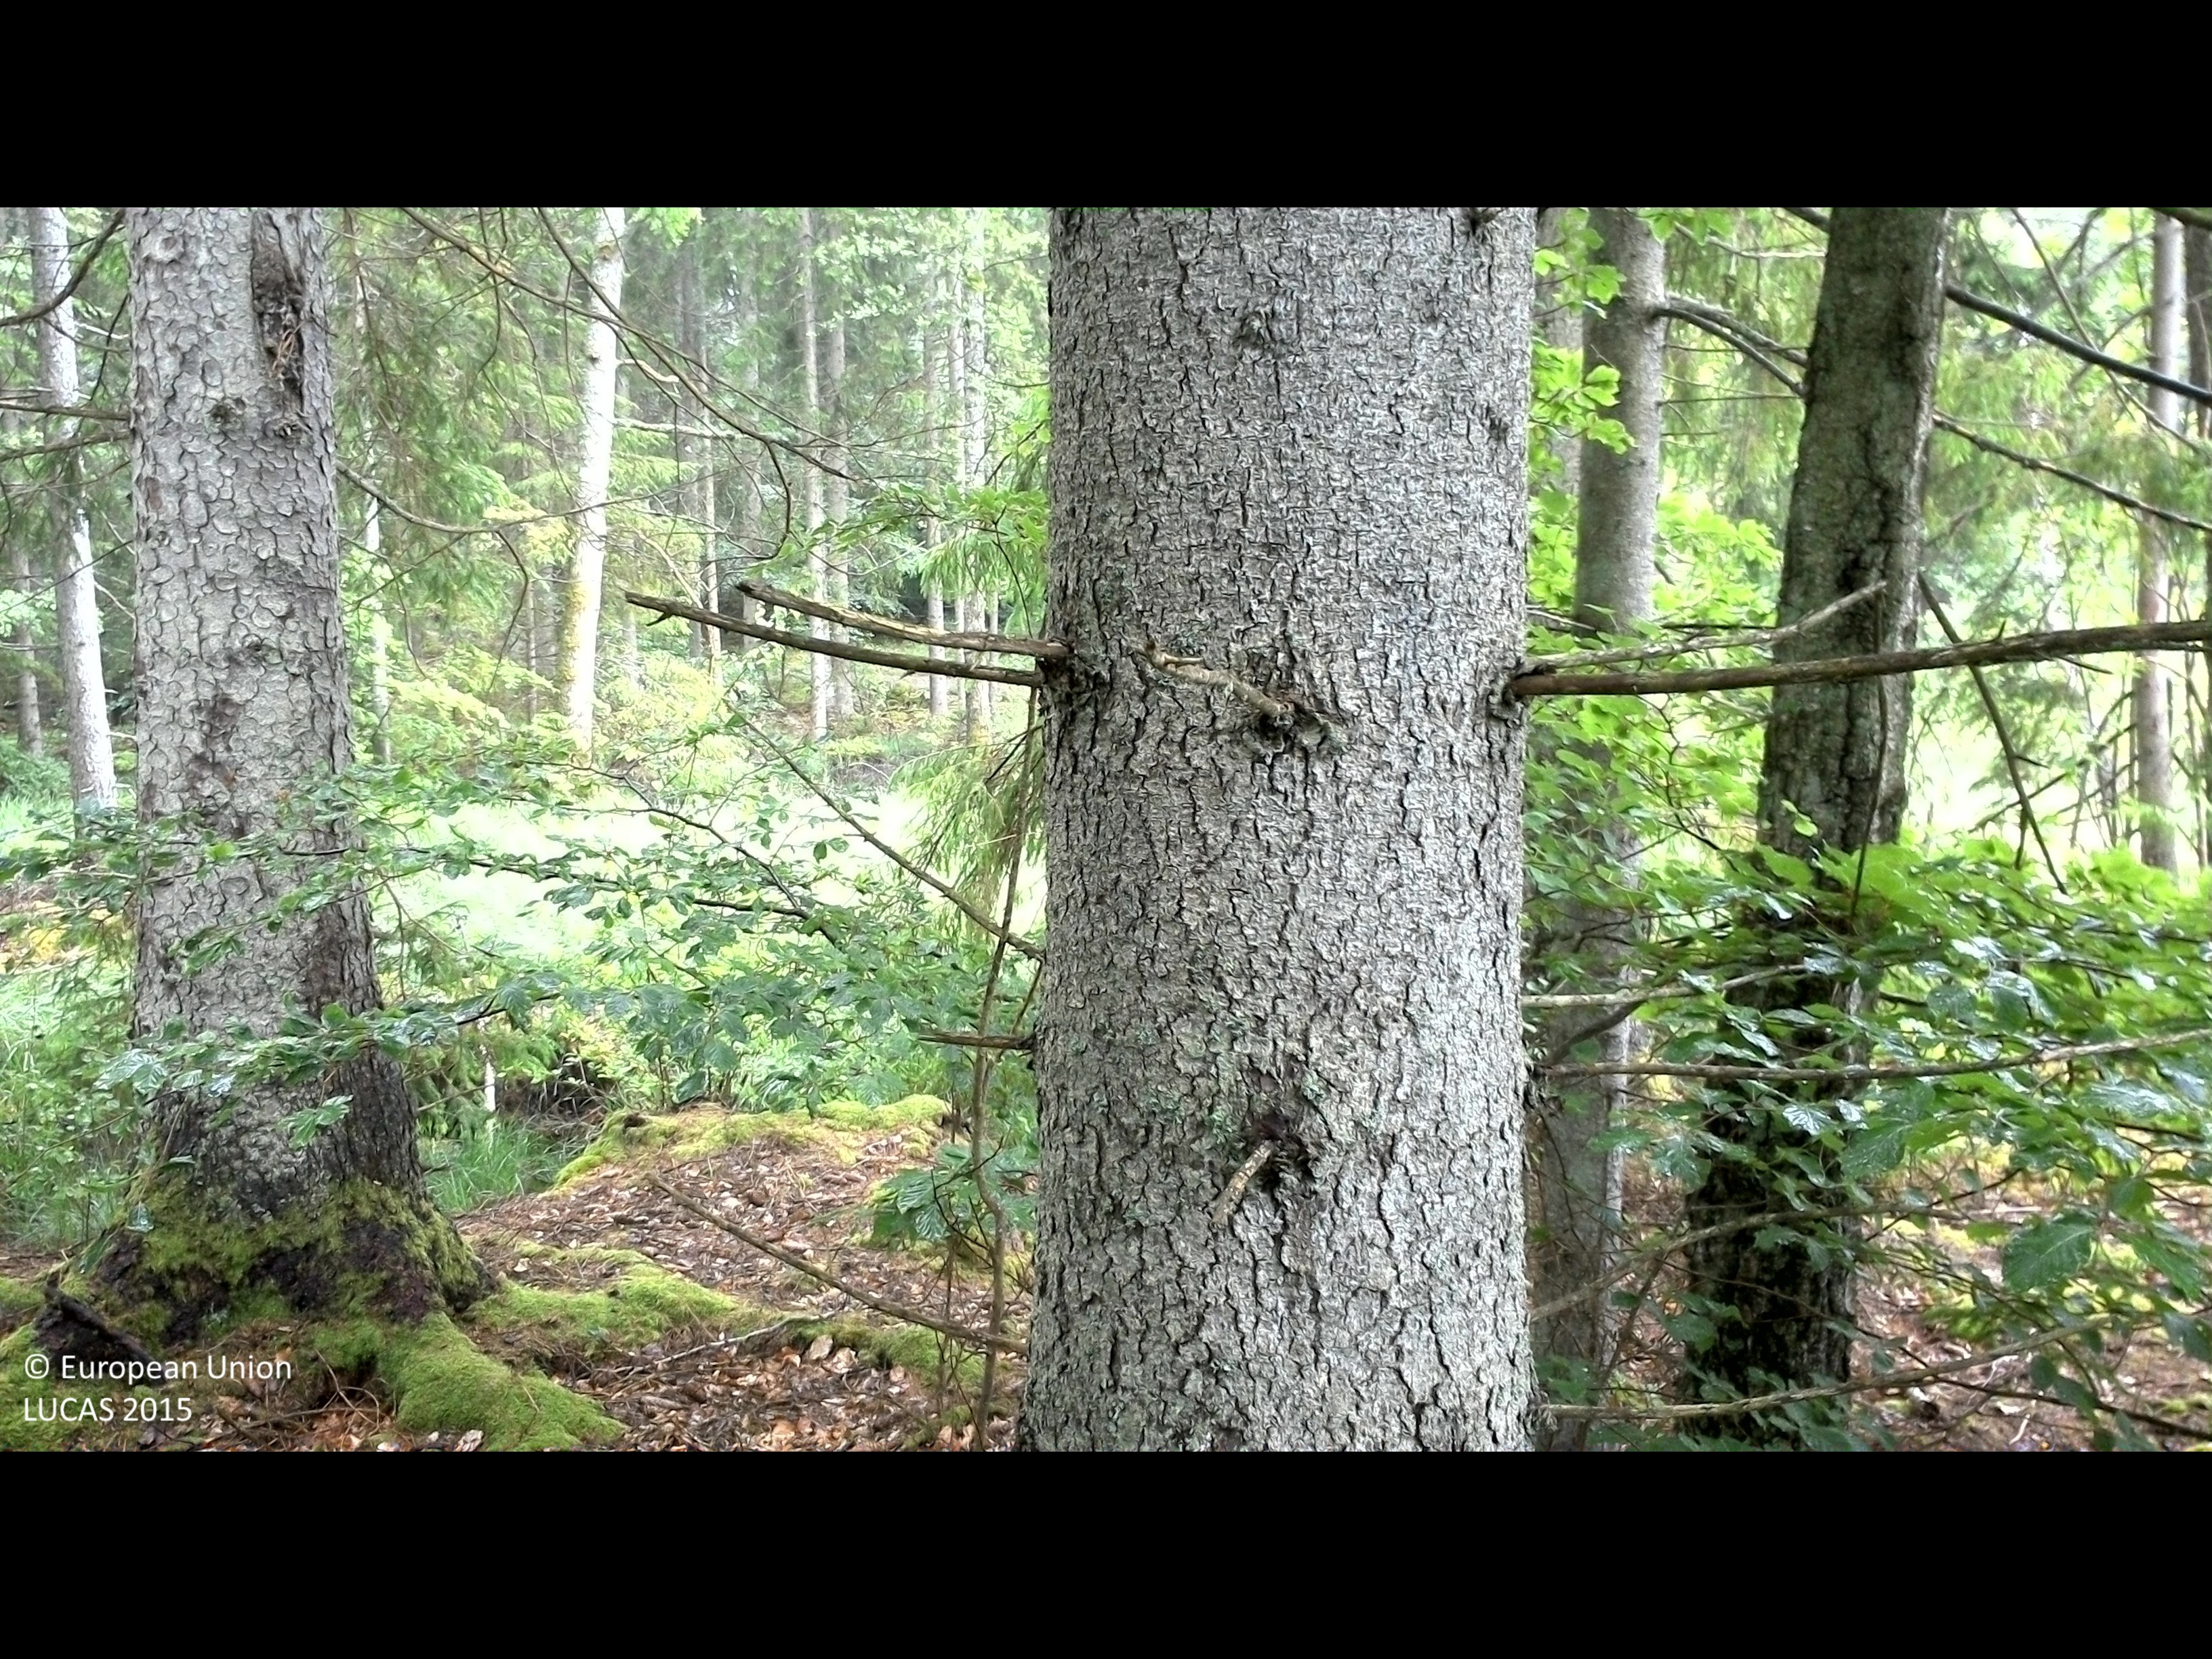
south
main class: Woodland
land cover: Spruce dominated coniferous woodland
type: boreal forest
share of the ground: > 75 %
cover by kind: coniferous forest trees 65 %, lichens and mosses 15 %, broadleaved forest trees 10 %, herbaceous plants 10 %
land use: Forestry
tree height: > 5 m
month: June
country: SE
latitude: 56.4284
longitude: 15.9511
